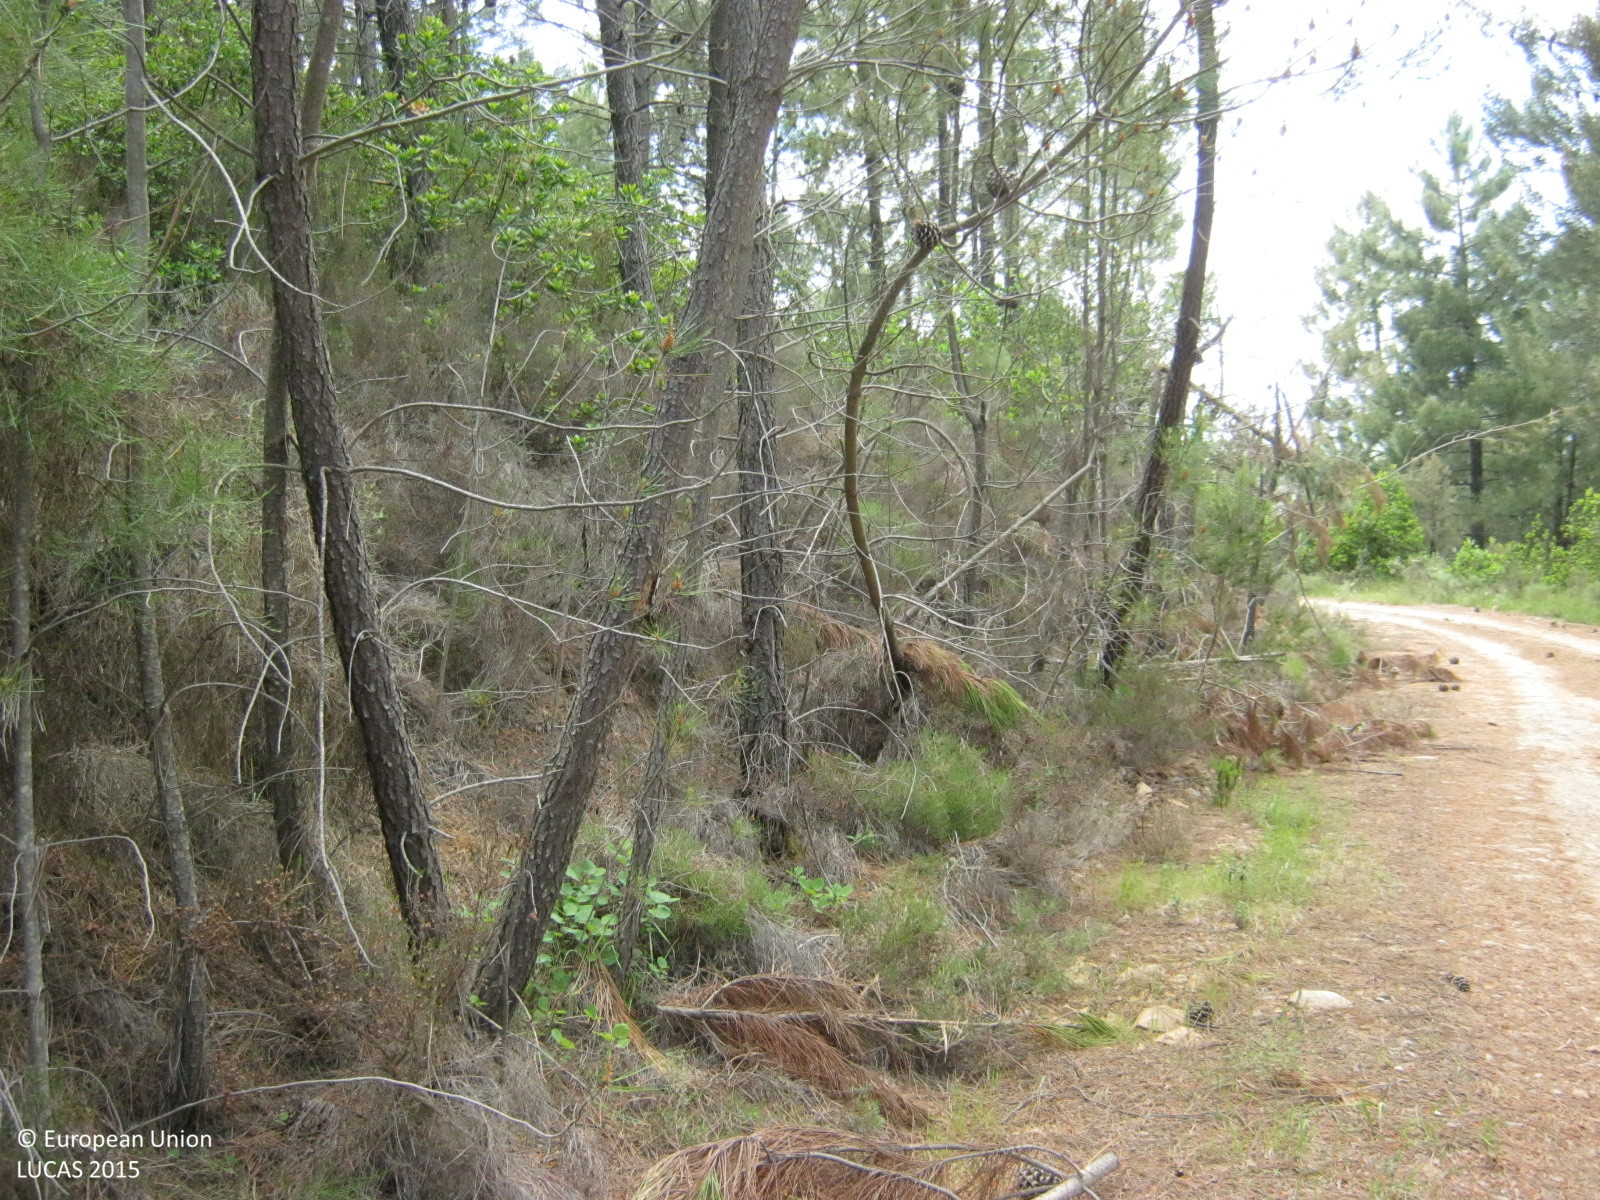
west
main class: Woodland
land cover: Pine dominated coniferous woodland
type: coniferous forest of the mediterranean region
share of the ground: > 75 %
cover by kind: coniferous forest trees 80 %, broadleaved forest trees 10 %, shrubs 10 %
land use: Forestry
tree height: > 5 m
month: May
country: GR
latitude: 37.2926
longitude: 22.3104
